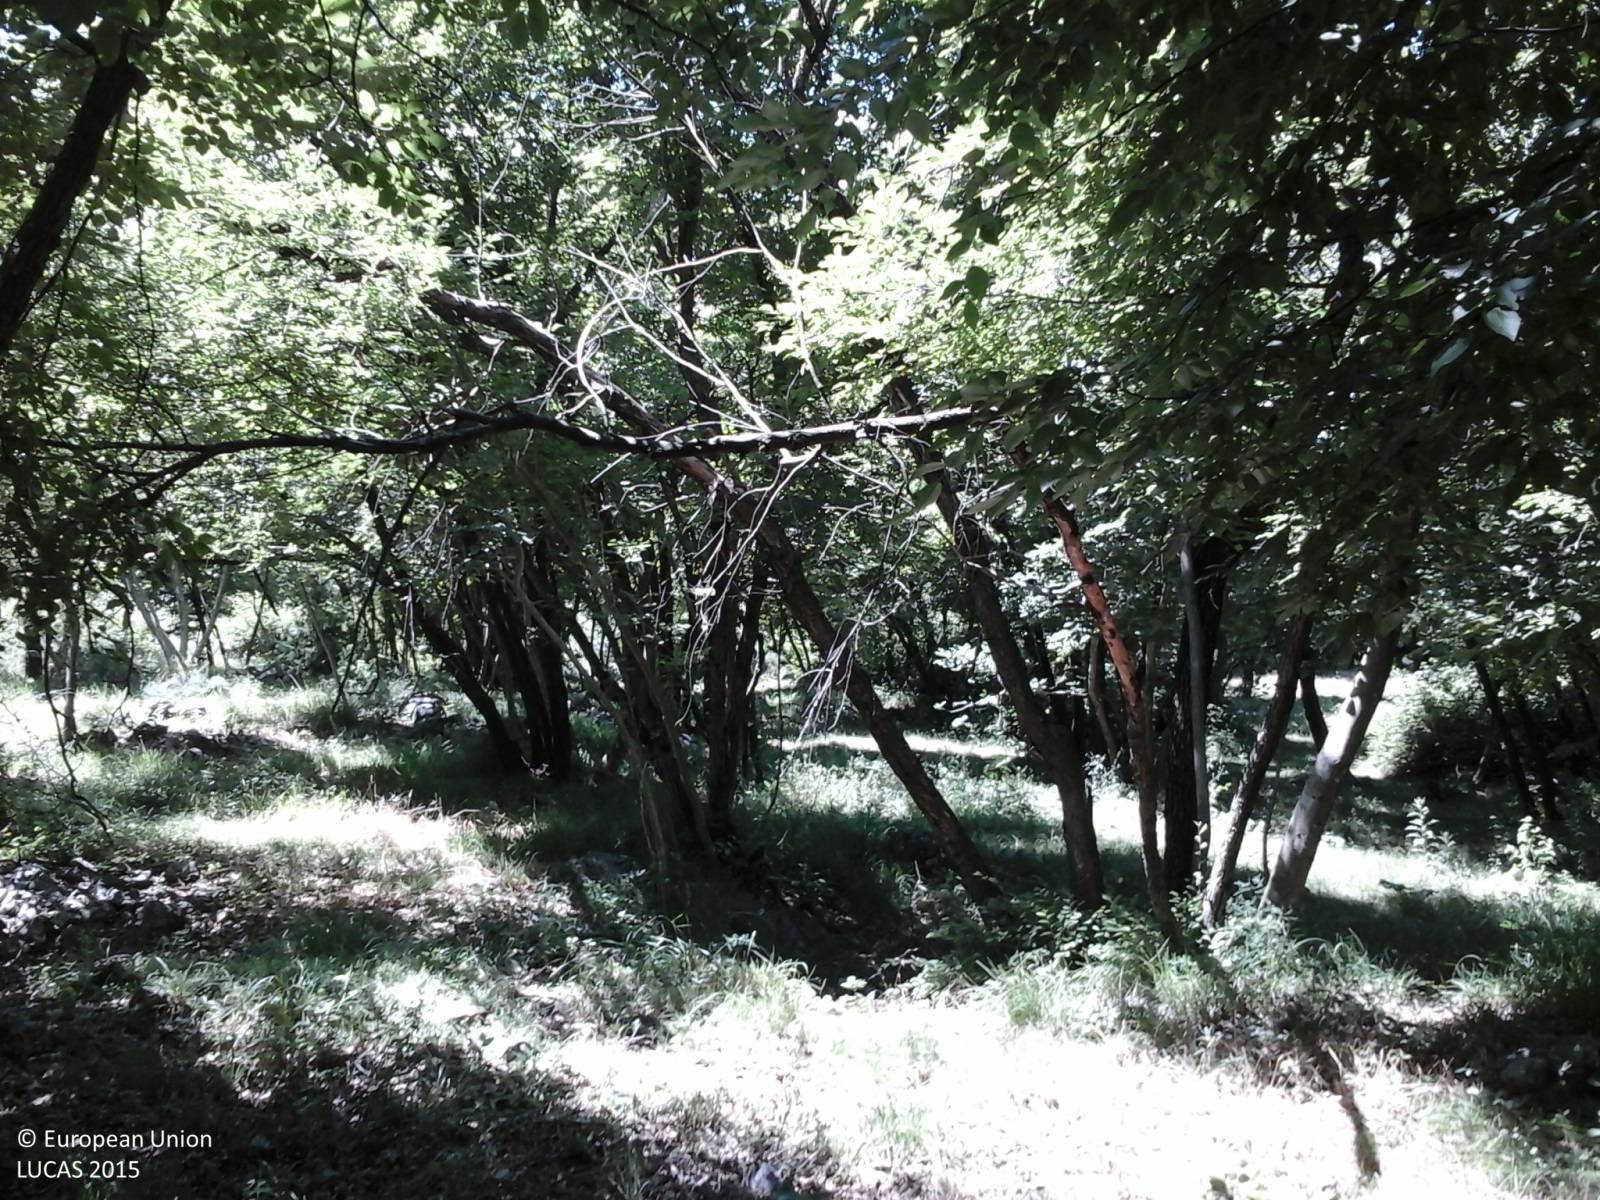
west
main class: Woodland
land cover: Broadleaved woodland
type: thermophilous deciduous forest
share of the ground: > 75 %
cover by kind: broadleaved forest trees 90 %, shrubs 10 %
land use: Forestry
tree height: > 5 m
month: June
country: IT
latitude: 45.7845
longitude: 13.6360
